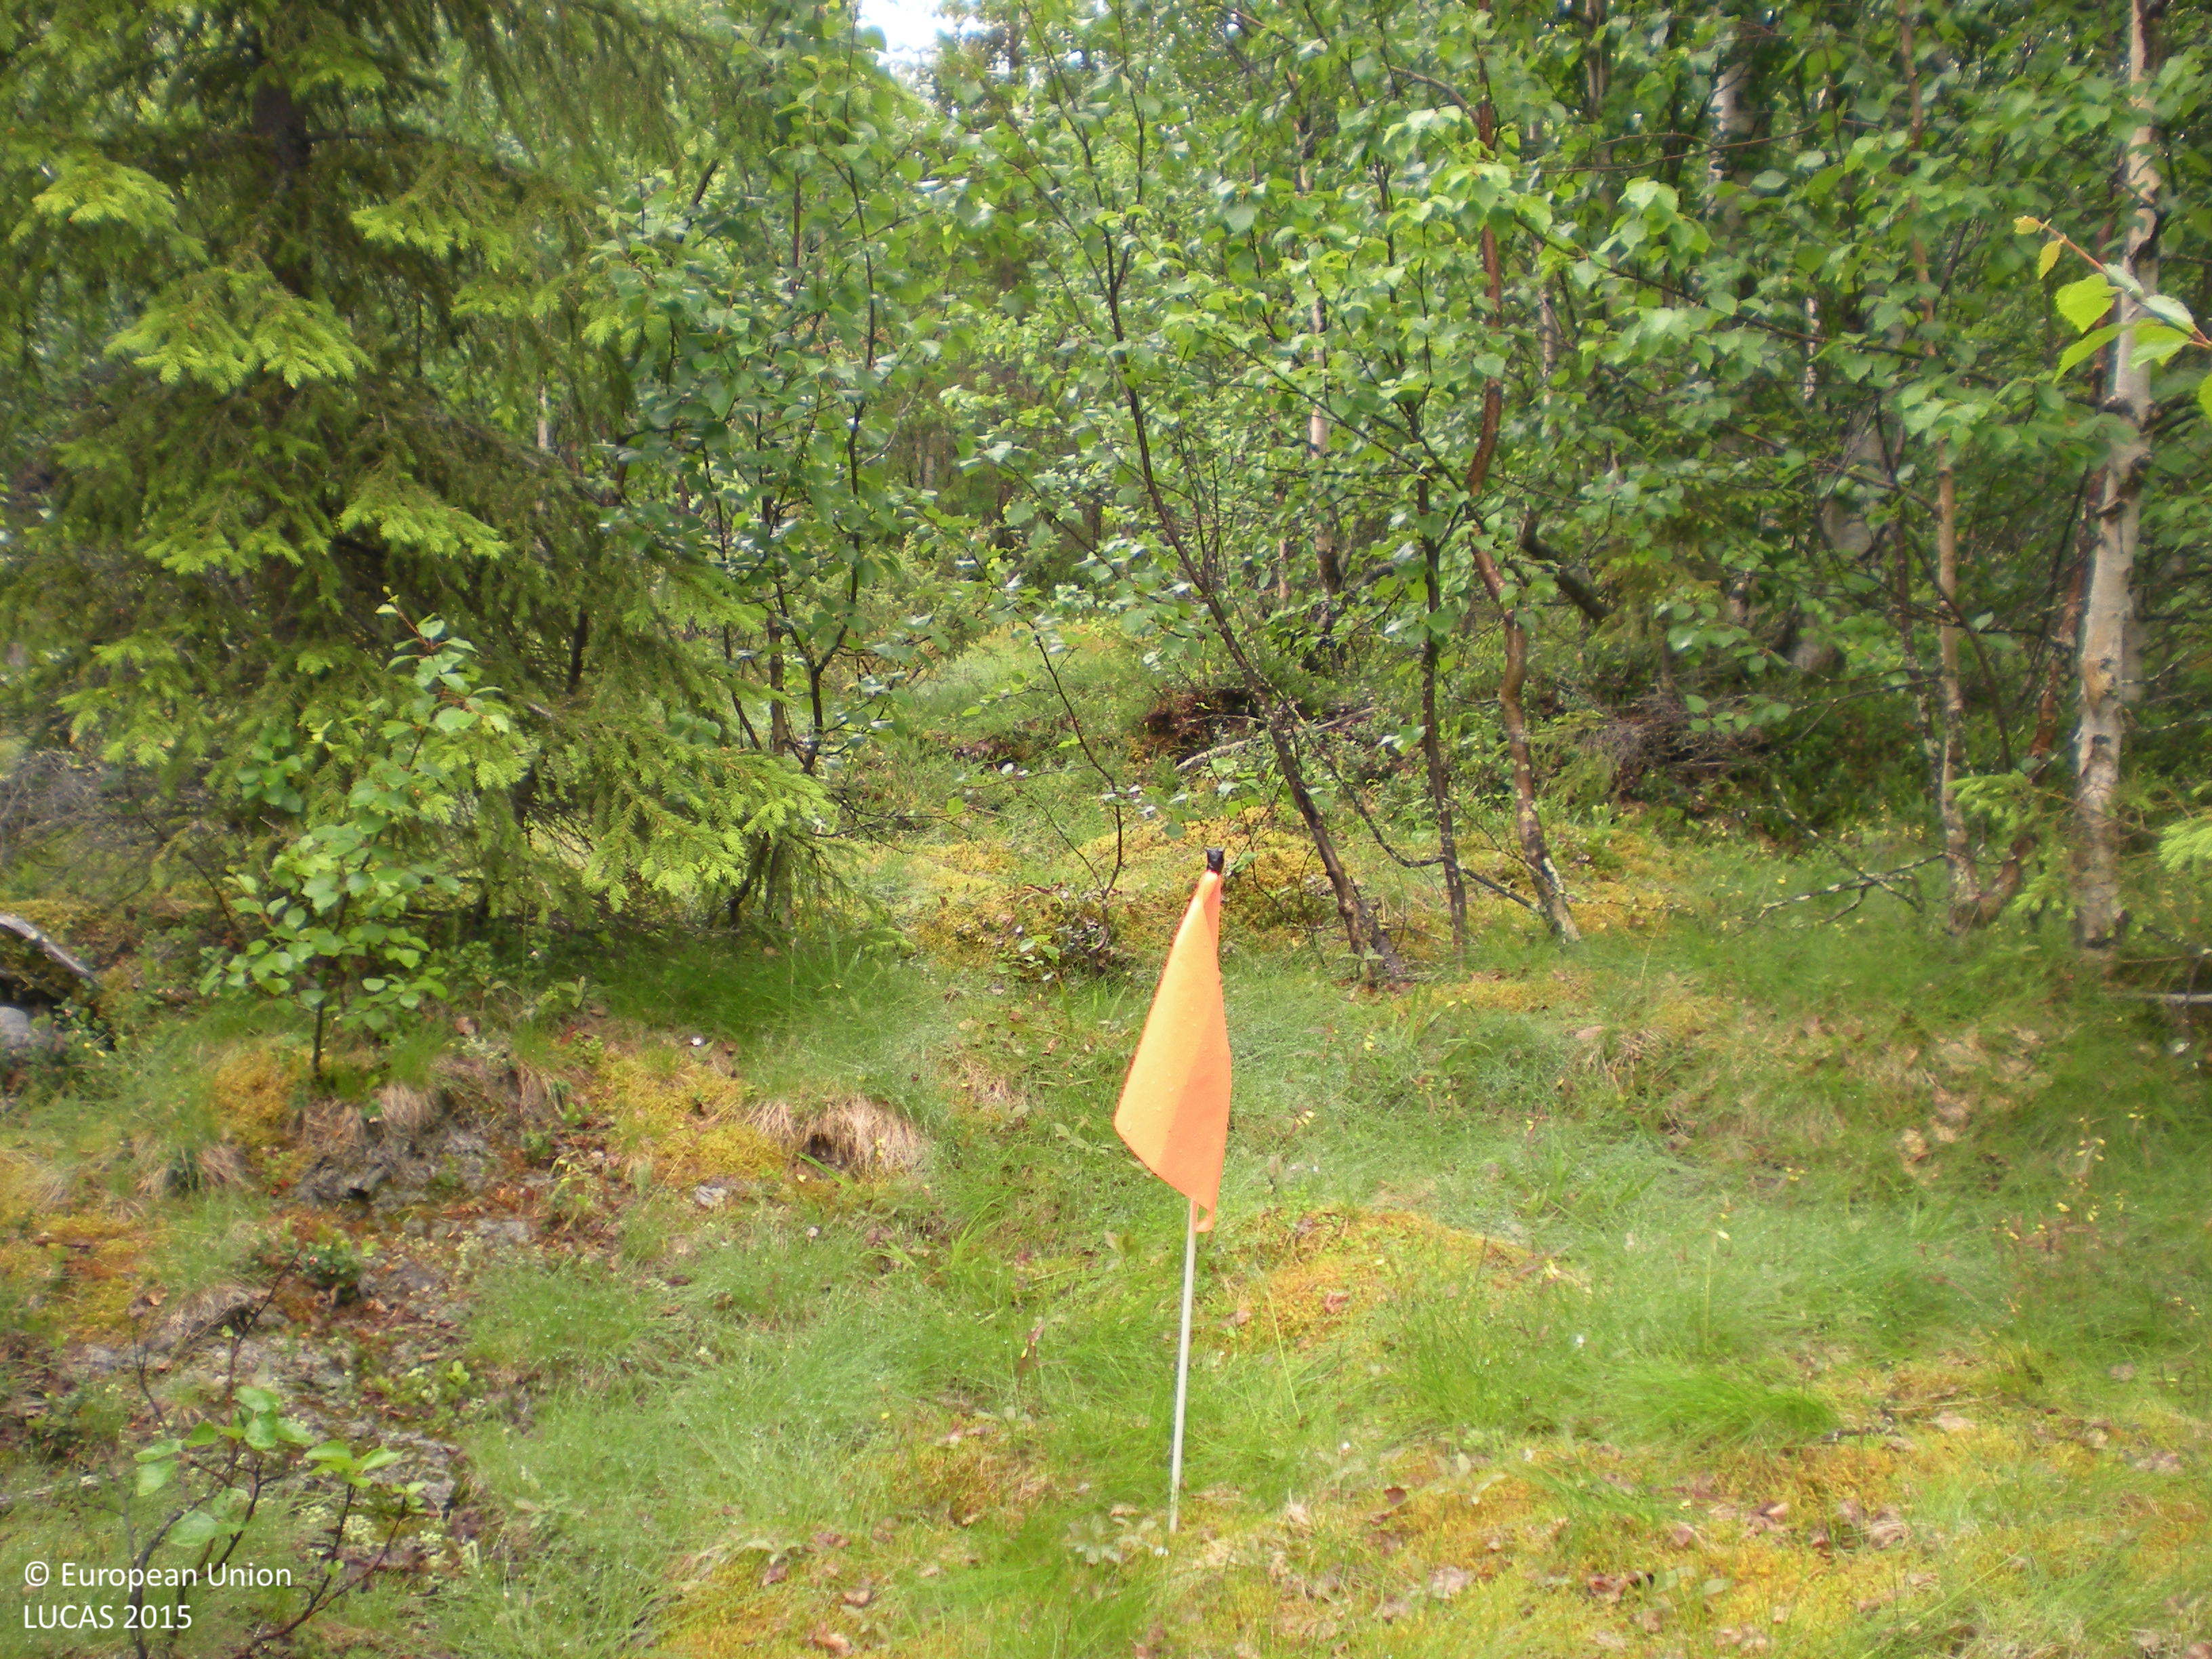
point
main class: Woodland
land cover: Spruce dominated mixed woodland
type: boreal forest
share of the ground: 50 - 75 %
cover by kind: broadleaved forest trees 55 %, coniferous forest trees 20 %, herbaceous plants 15 %, lichens and mosses 10 %
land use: Forestry
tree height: > 5 m
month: July
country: SE
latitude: 65.8700
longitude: 17.1697
